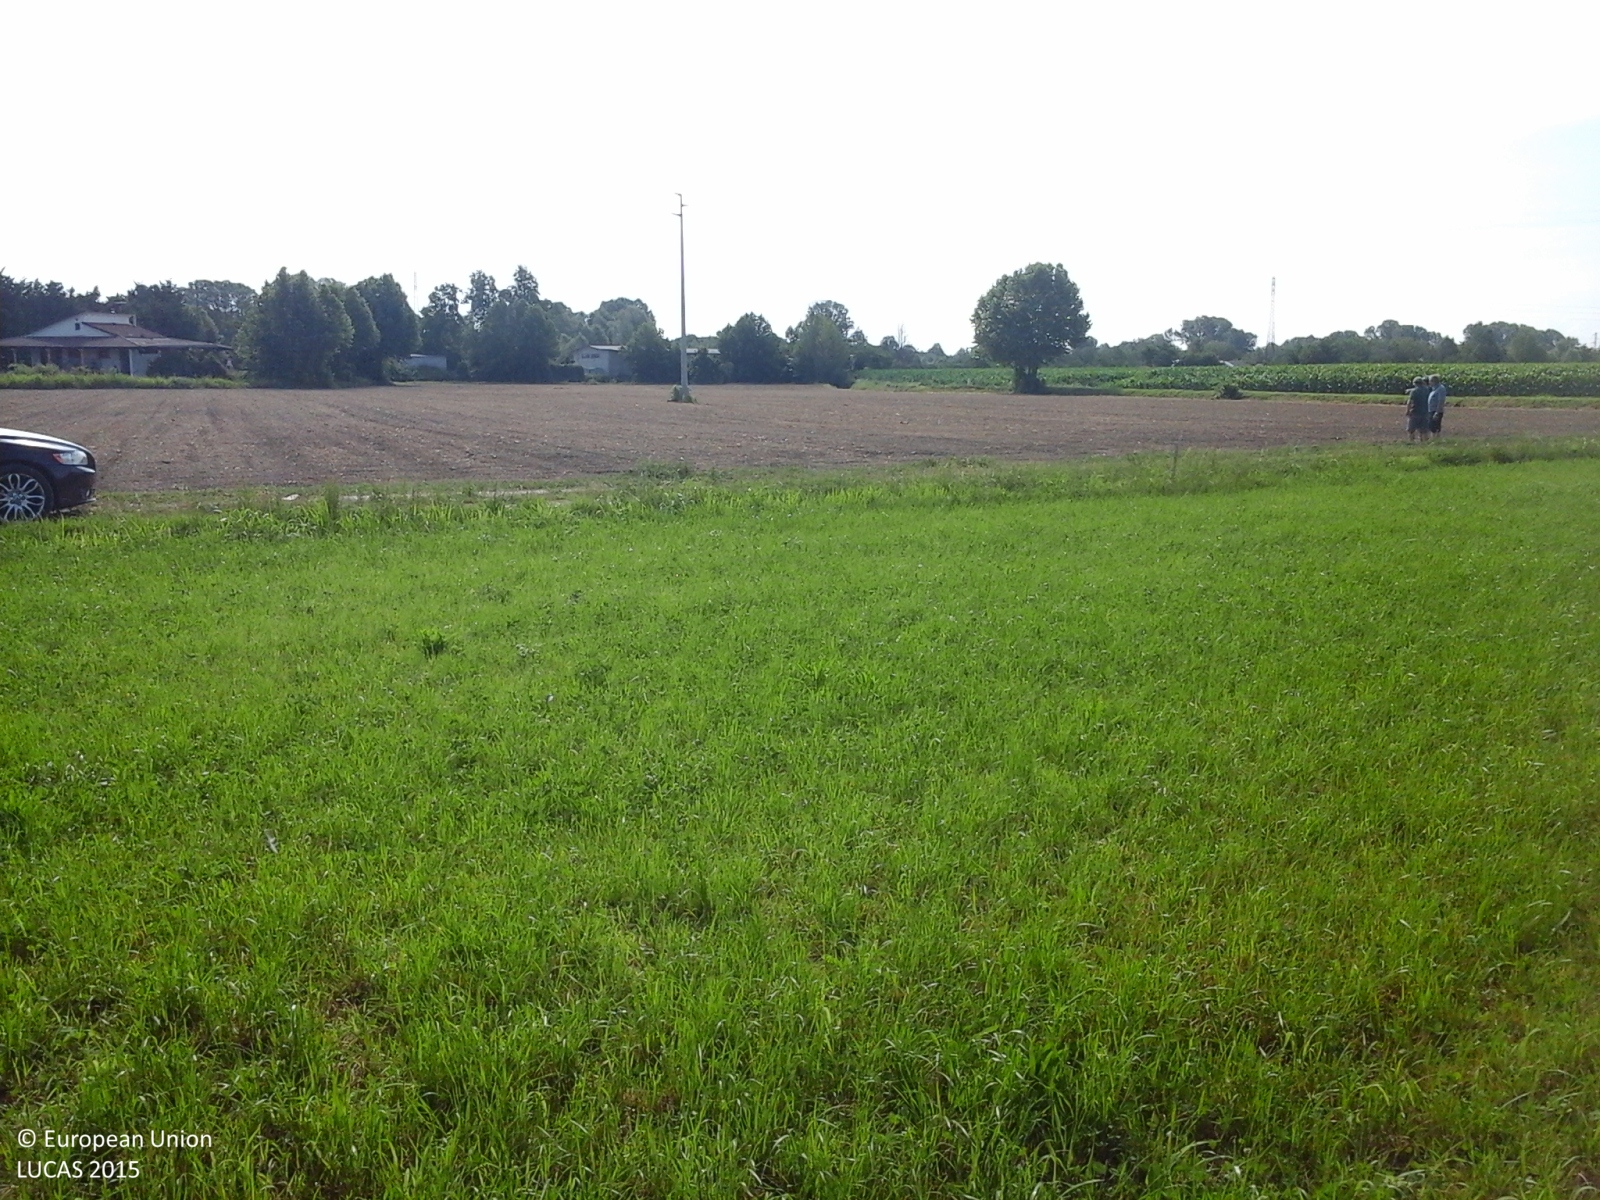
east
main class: Grassland
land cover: Grassland without tree/shrub cover
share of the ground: > 75 %
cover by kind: herbaceous plants 100 %
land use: Agriculture (excluding fallow land and kitchen gardens)
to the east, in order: Grassland without tree/shrub cover; Tracks; Grass margins; Other bare soil; Electric lines; Other bare soil; Grass margins; Inland fresh running water; Artificial constructions in urban areas
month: June
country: IT
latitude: 45.4085
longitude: 11.1097
